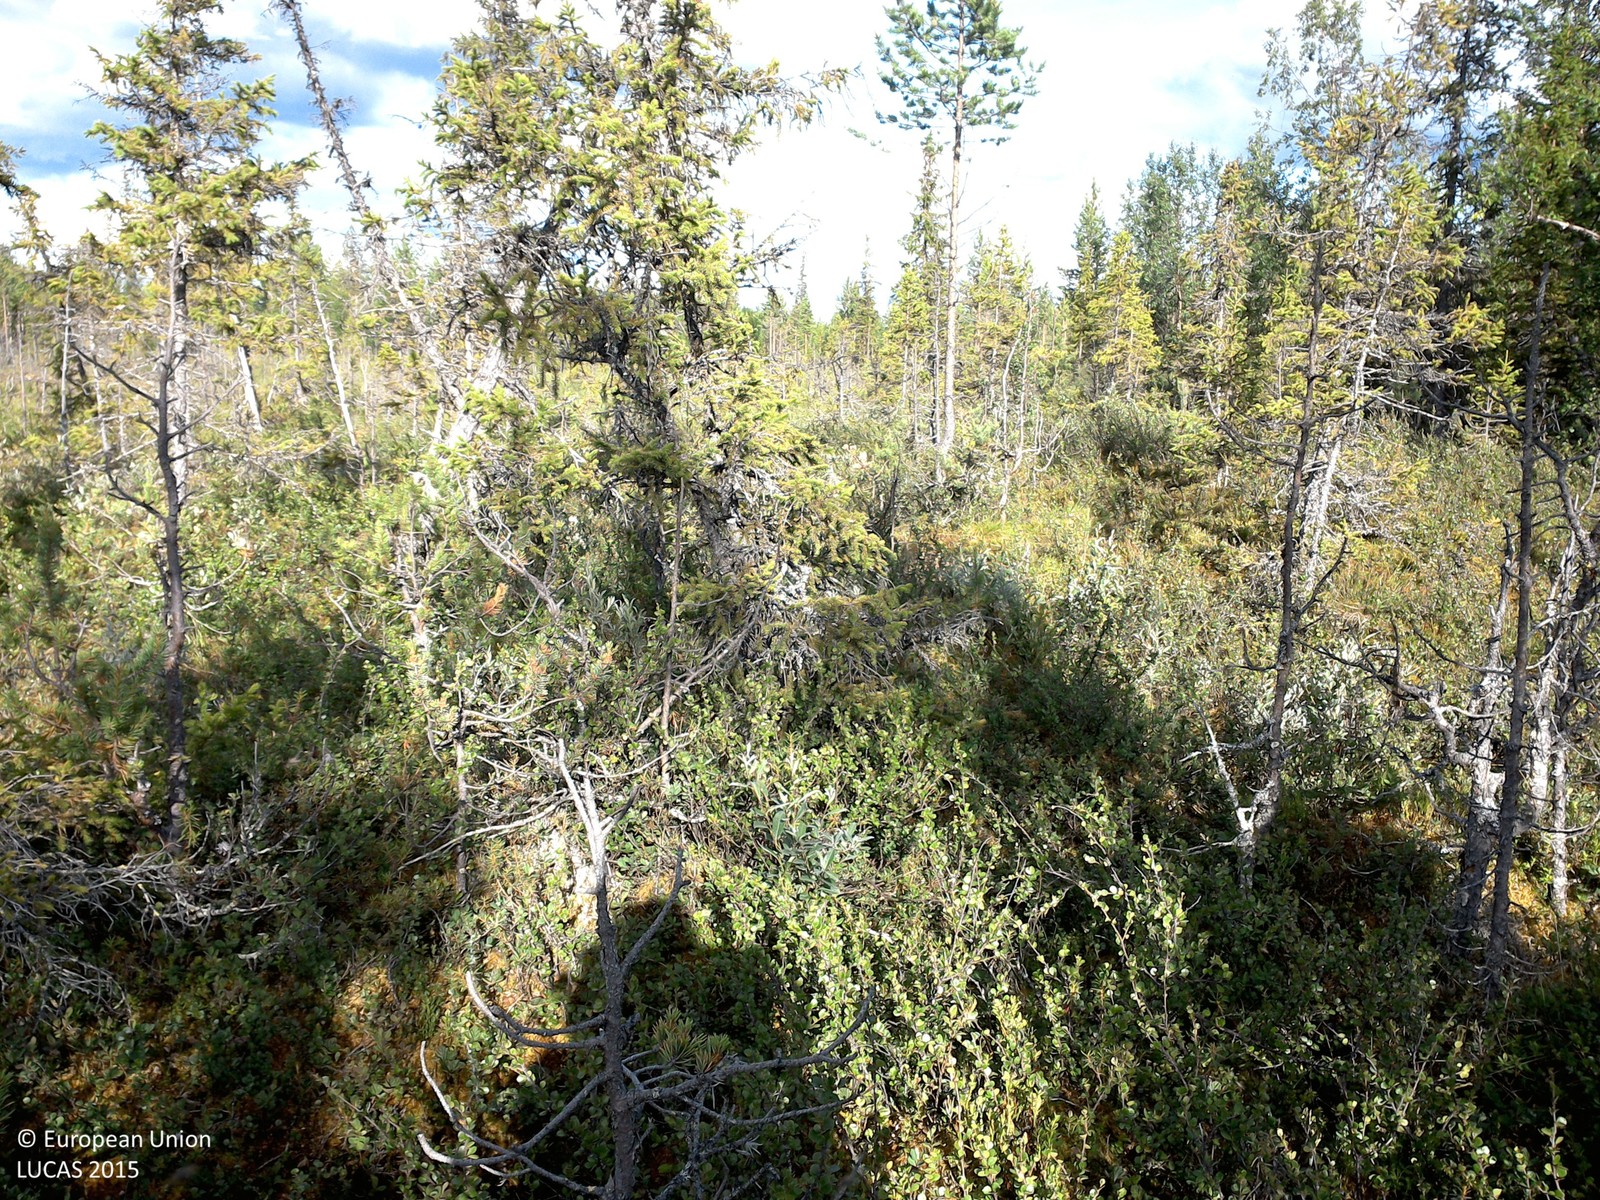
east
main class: Woodland
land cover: Pine dominated coniferous woodland
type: boreal forest
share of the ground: 10 - 25 %
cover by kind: shrubs 75 %, coniferous forest trees 15 %, lichens and mosses 10 %
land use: Semi-natural and natural areas not in use
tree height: > 5 m
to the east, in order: Pine dominated coniferous woodland; Pine dominated mixed woodland
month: July
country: SE
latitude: 67.7224
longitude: 21.1251
